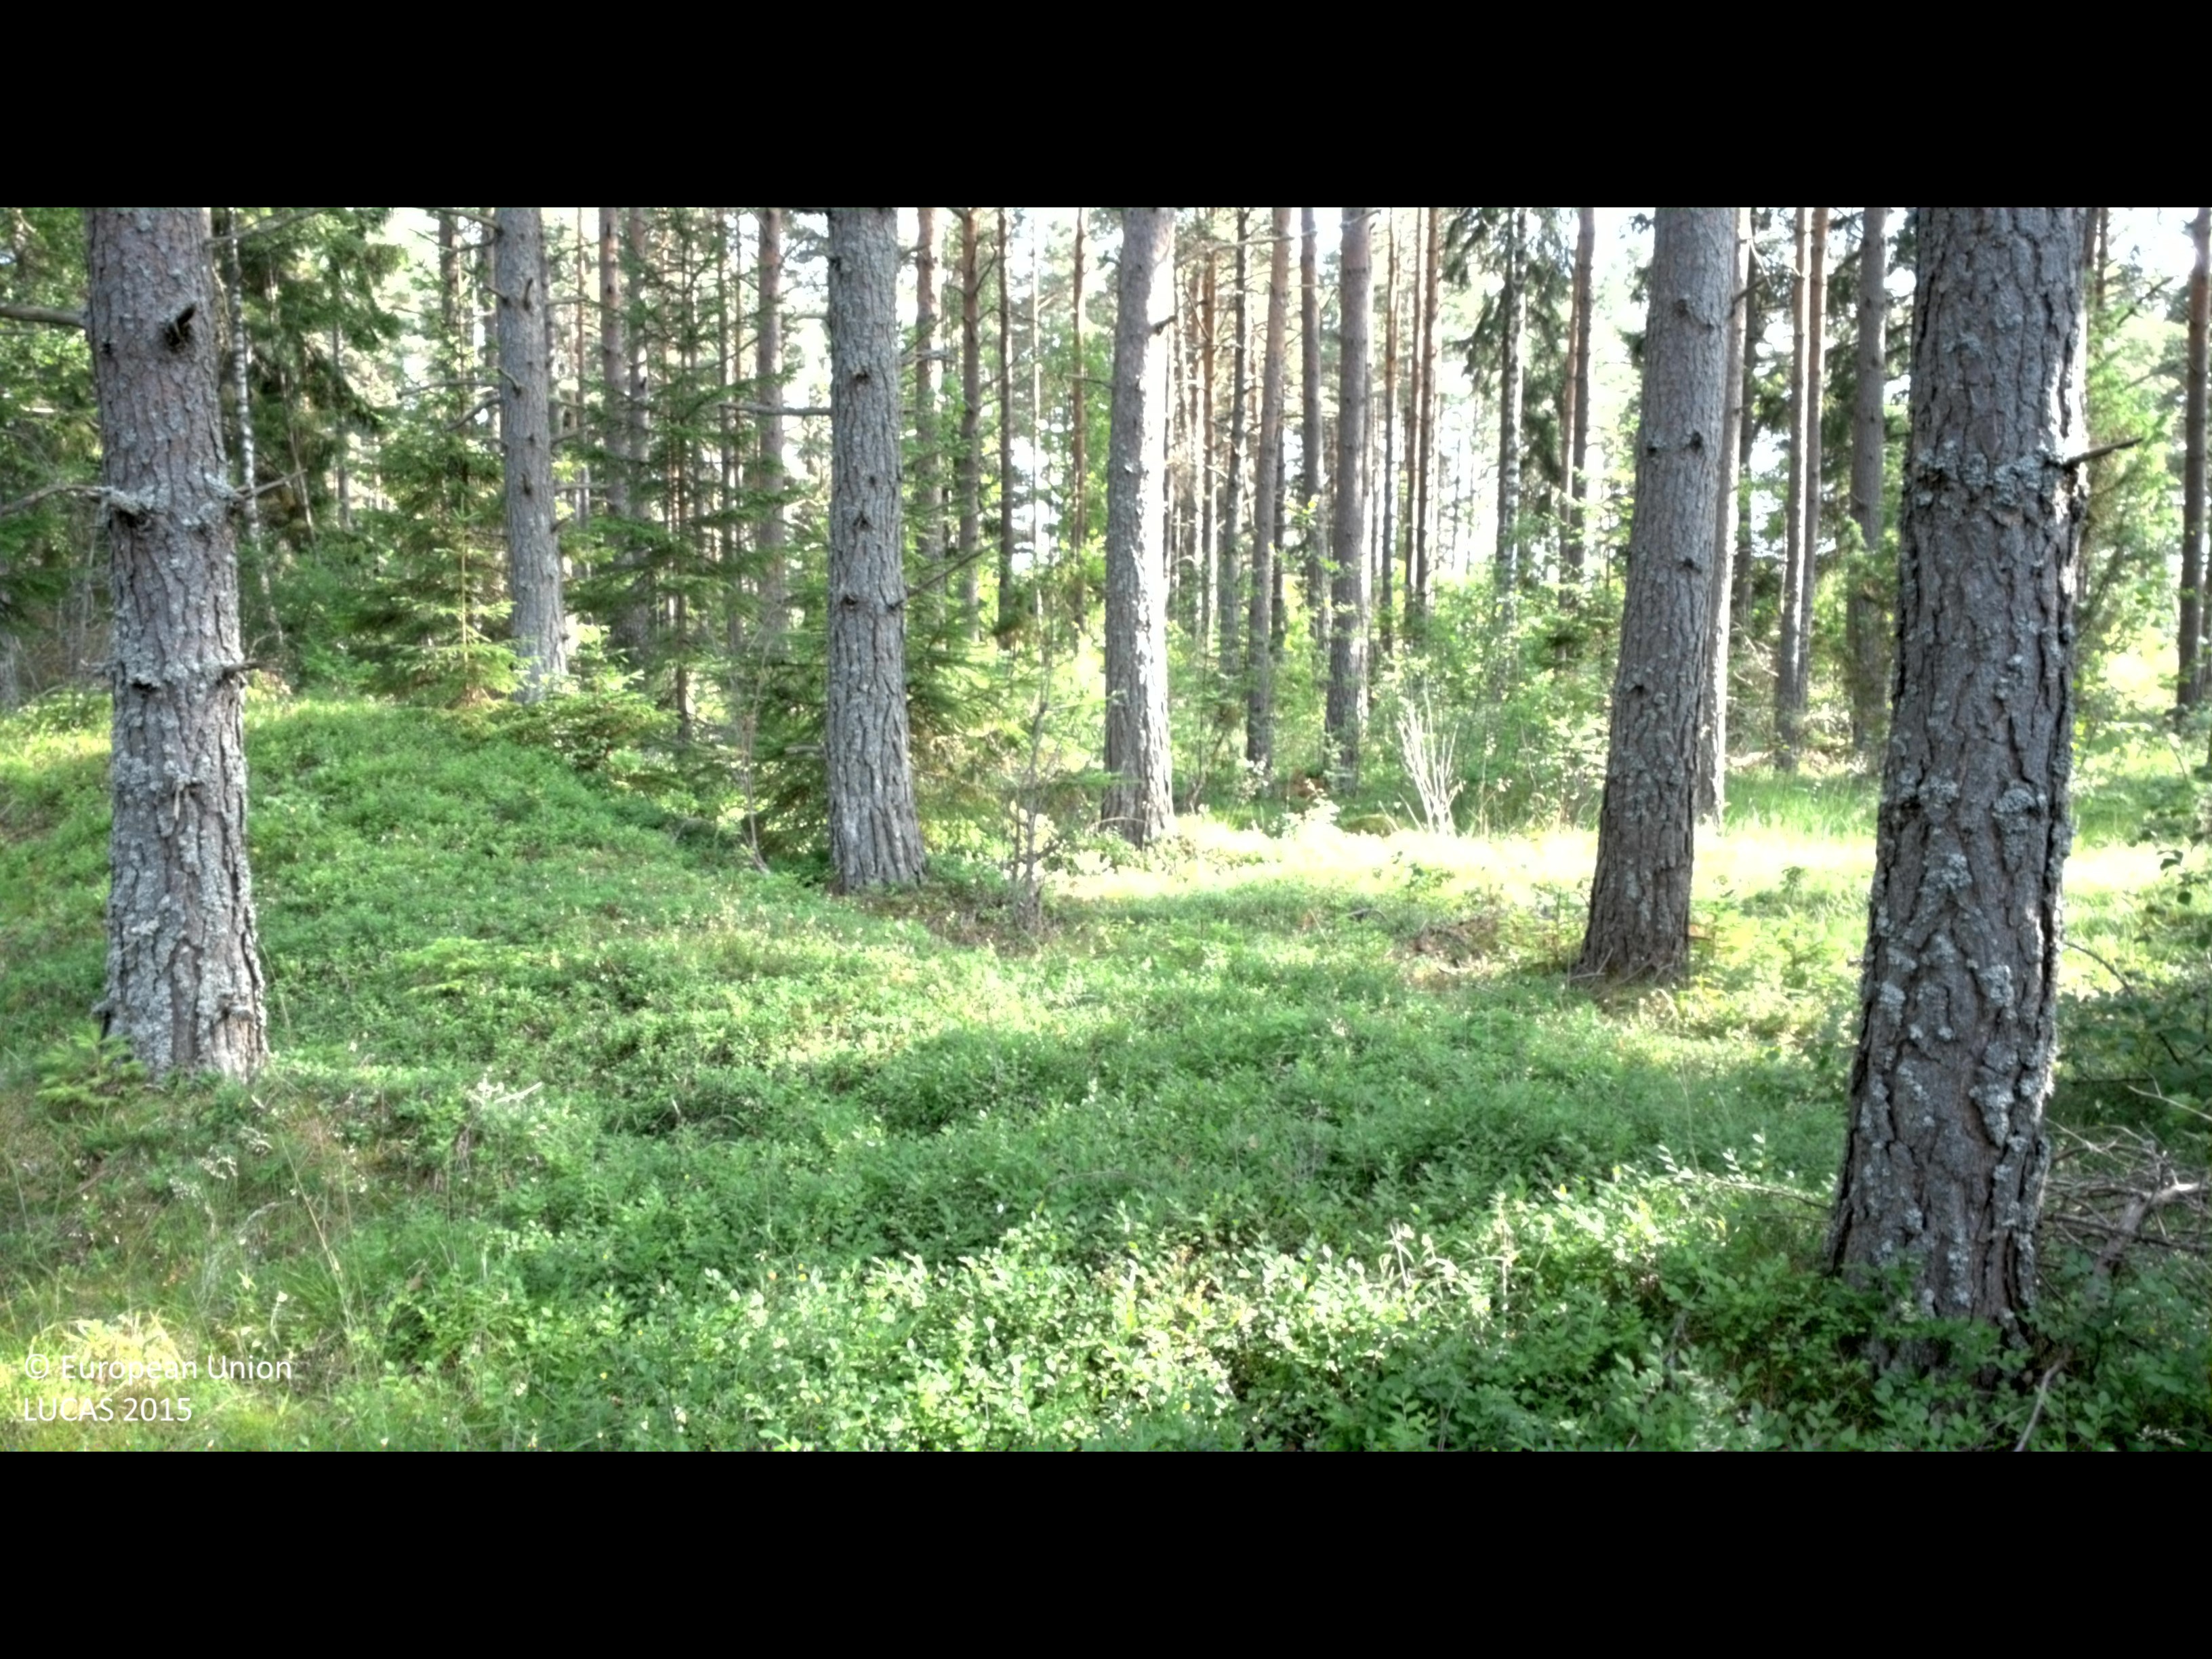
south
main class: Woodland
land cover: Pine dominated coniferous woodland
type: boreal forest
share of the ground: 50 - 75 %
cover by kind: coniferous forest trees 65 %, shrubs 20 %, herbaceous plants 10 %, broadleaved forest trees 5 %
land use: Forestry
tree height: > 5 m
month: July
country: SE
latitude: 58.3962
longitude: 16.6865
